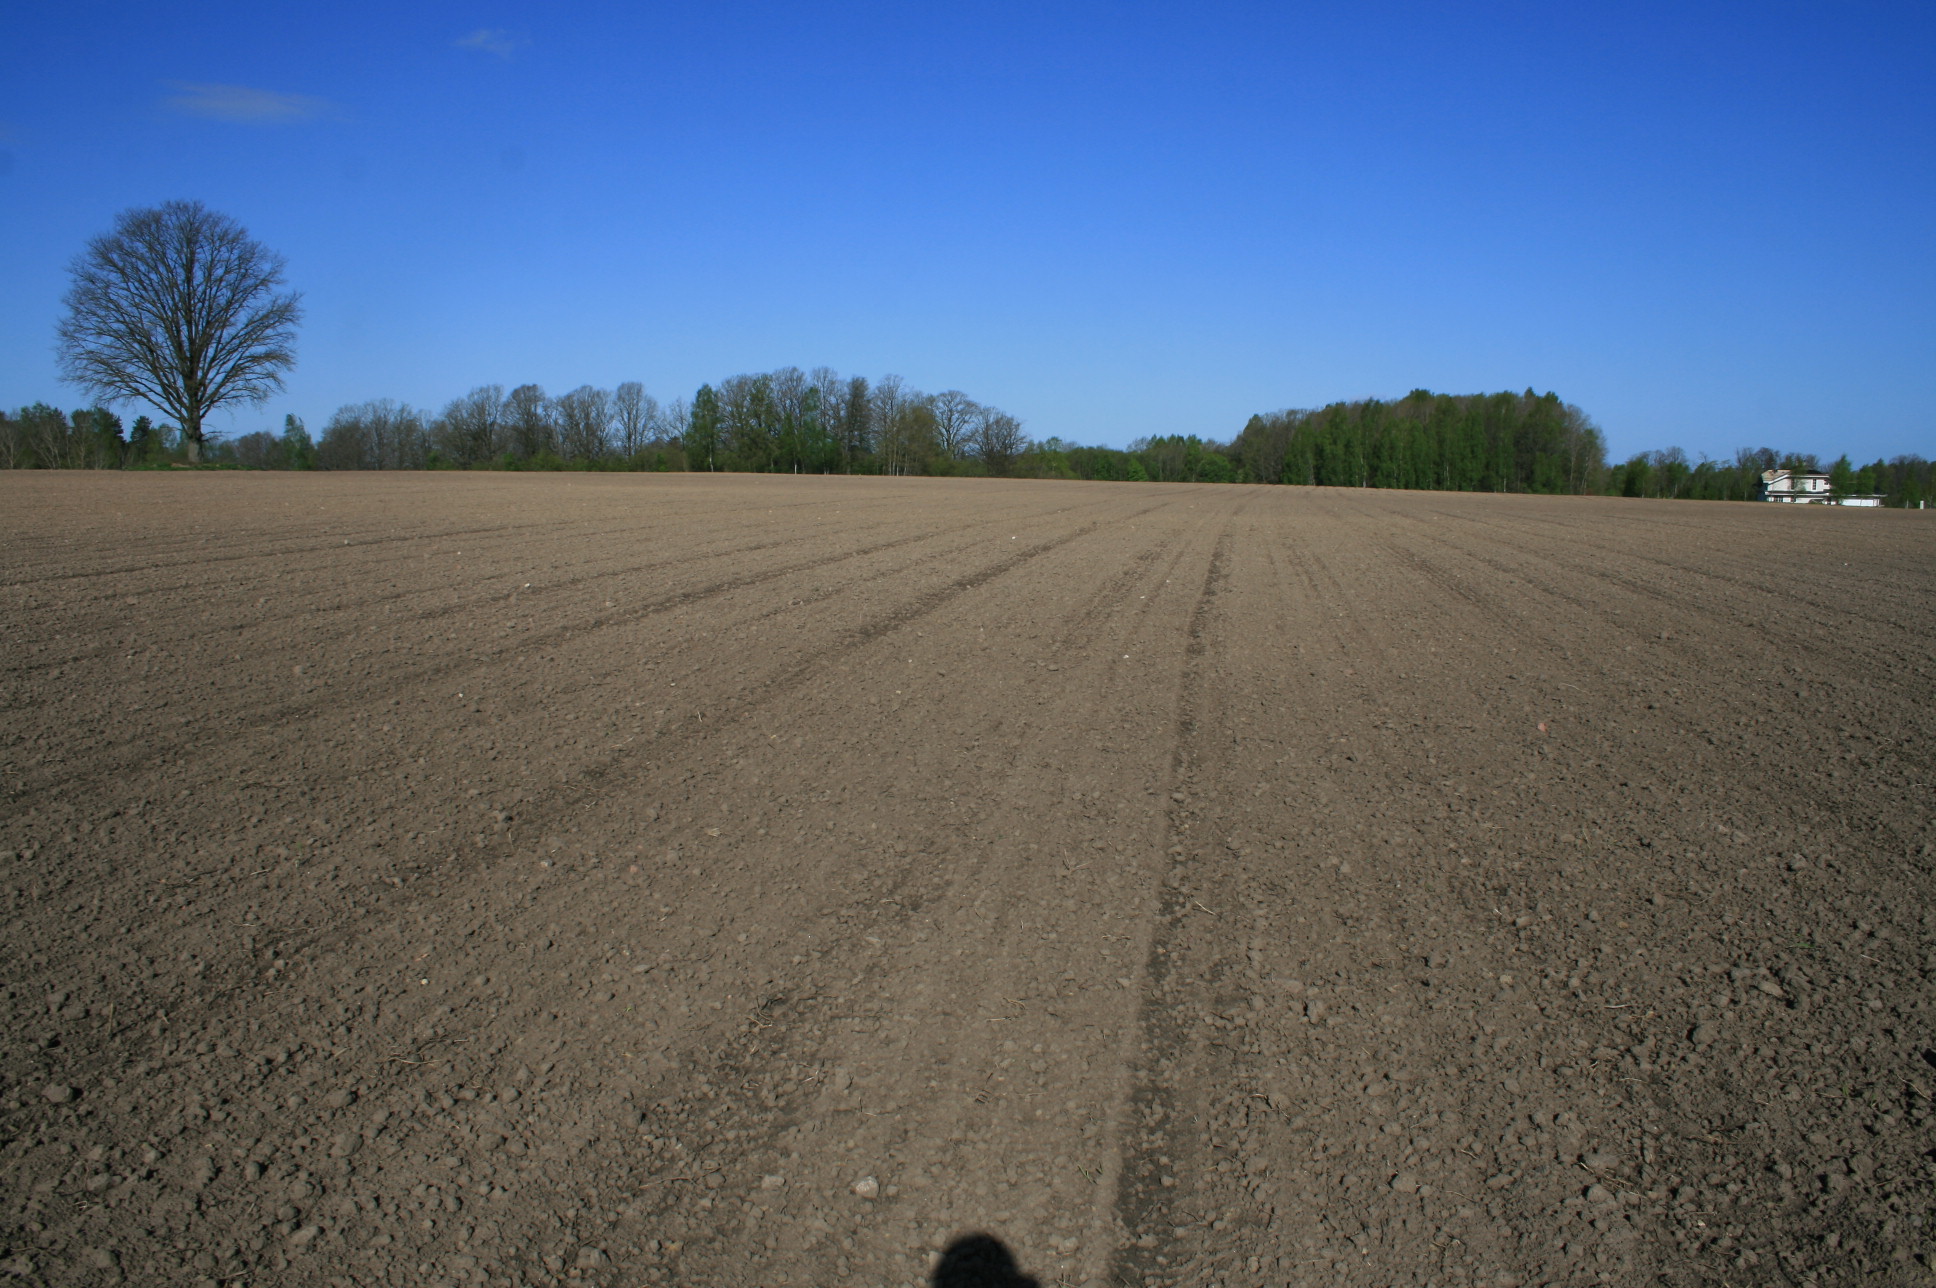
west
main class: Cropland
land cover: Dry pulses
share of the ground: < 10 %
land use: Agriculture (excluding fallow land and kitchen gardens)
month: May
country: LT
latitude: 56.2490
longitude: 21.5181
